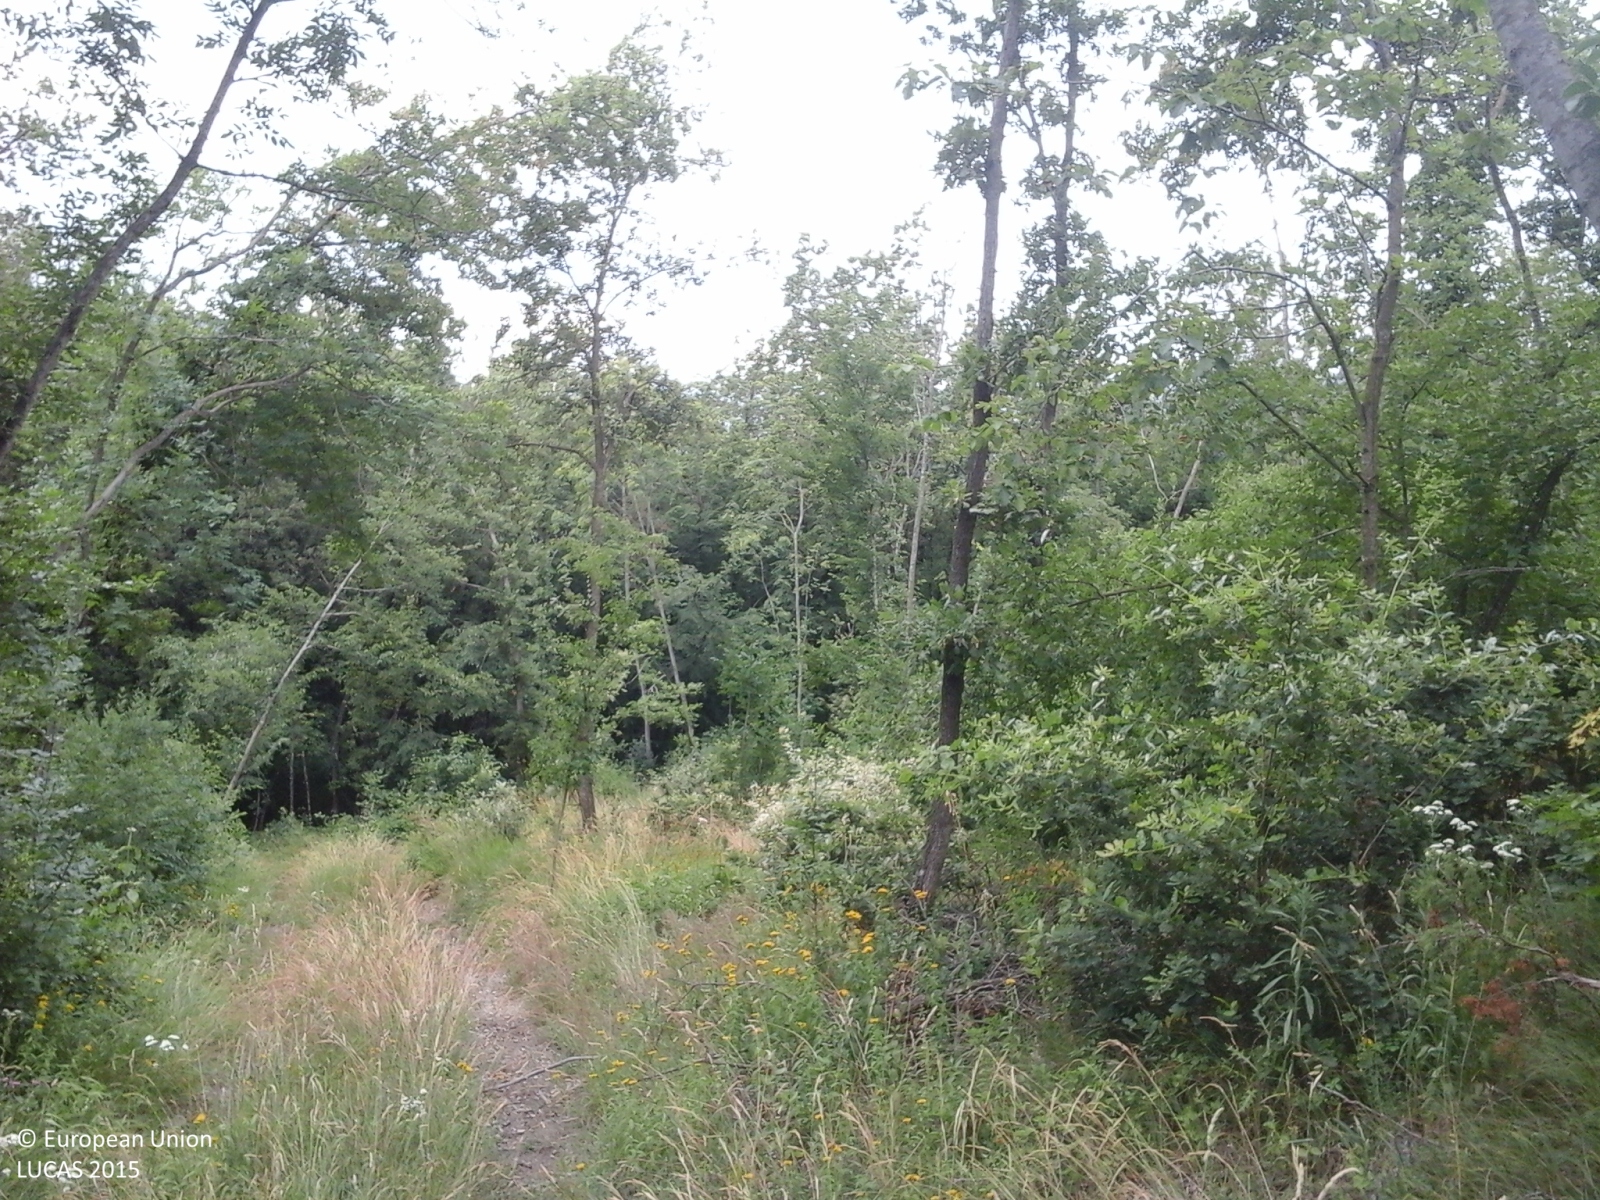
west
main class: Woodland
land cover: Broadleaved woodland
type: thermophilous deciduous forest
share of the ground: > 75 %
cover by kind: broadleaved forest trees 100 %
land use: Forestry
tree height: > 5 m
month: June
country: IT
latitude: 44.5667
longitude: 10.2387
